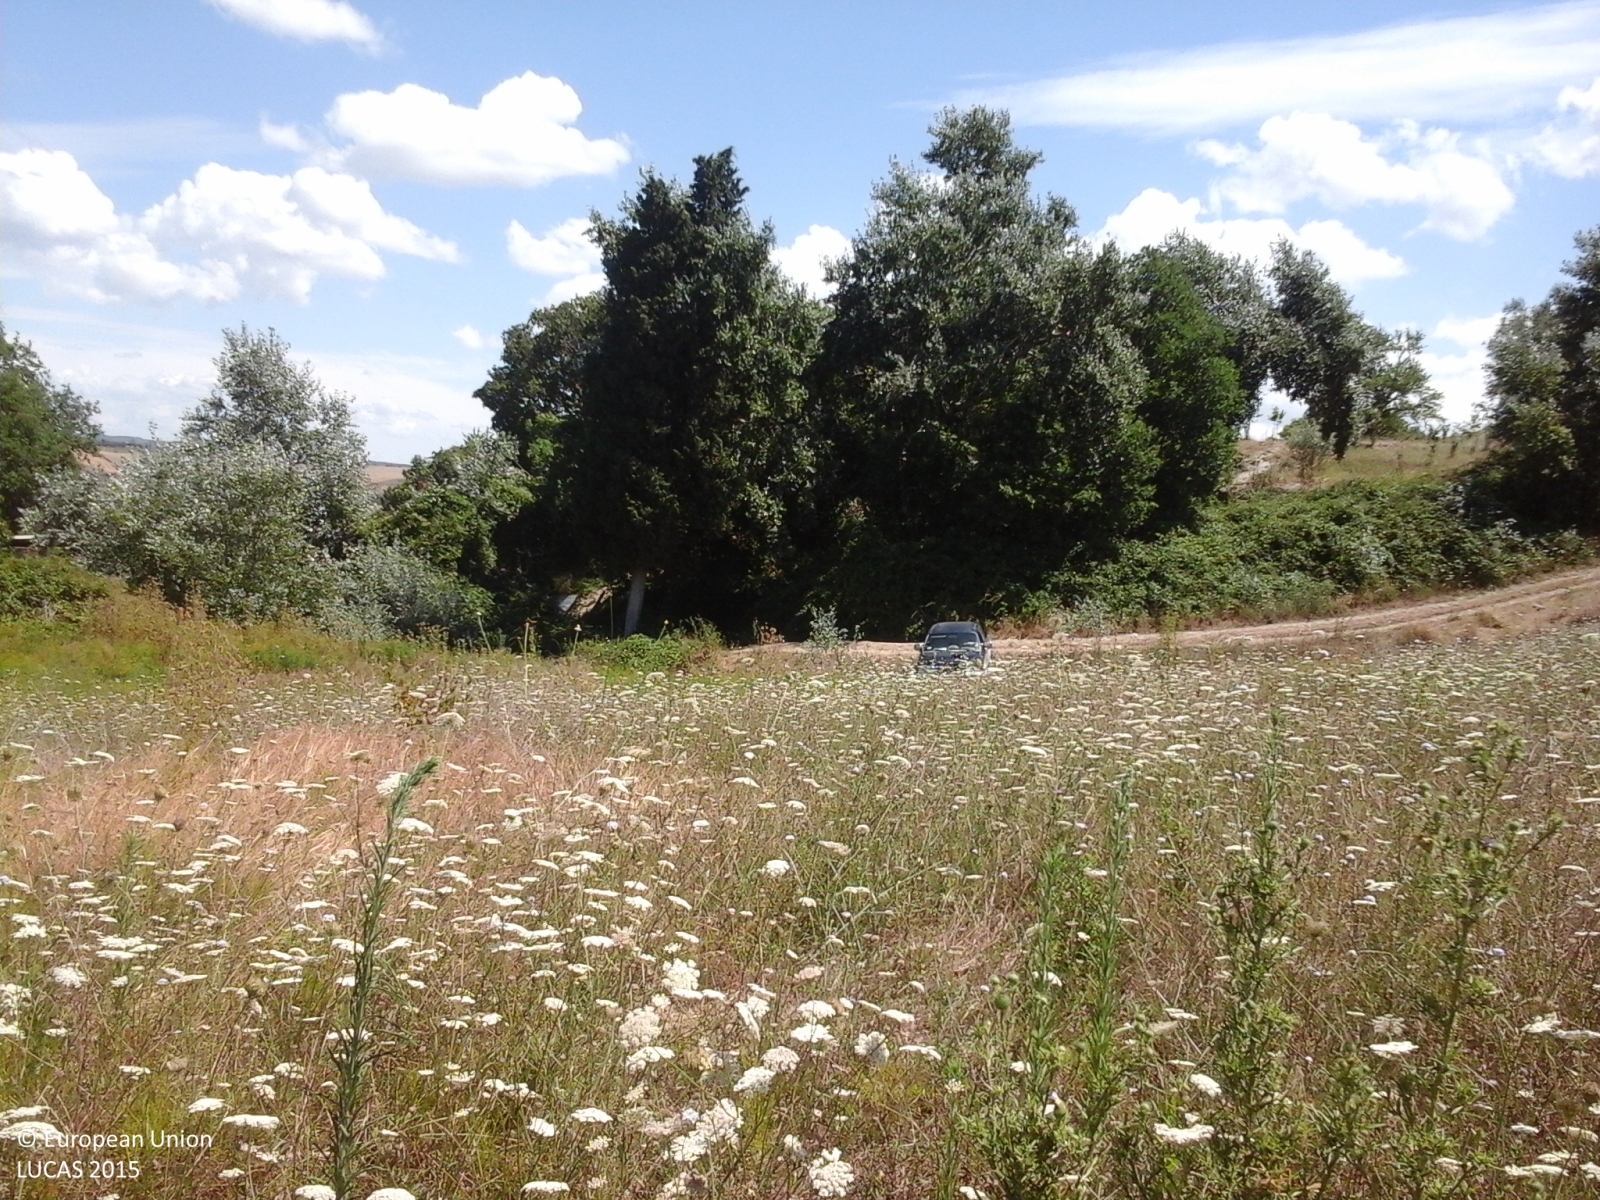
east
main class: Grassland
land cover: Grassland without tree/shrub cover
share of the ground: > 75 %
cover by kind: herbaceous plants 100 %
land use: Agriculture (excluding fallow land and kitchen gardens)
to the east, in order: Grassland without tree/shrub cover; Shrubland without tree cover; Grassland without tree/shrub cover; Broadleaved woodland; Tracks; Grassland without tree/shrub cover; Grassland with sparse tree/shrub cover; Shrubland without tree cover; Fences; Other leguminous and mixtures for fodder
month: August
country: IT
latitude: 43.1838
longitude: 11.5579
